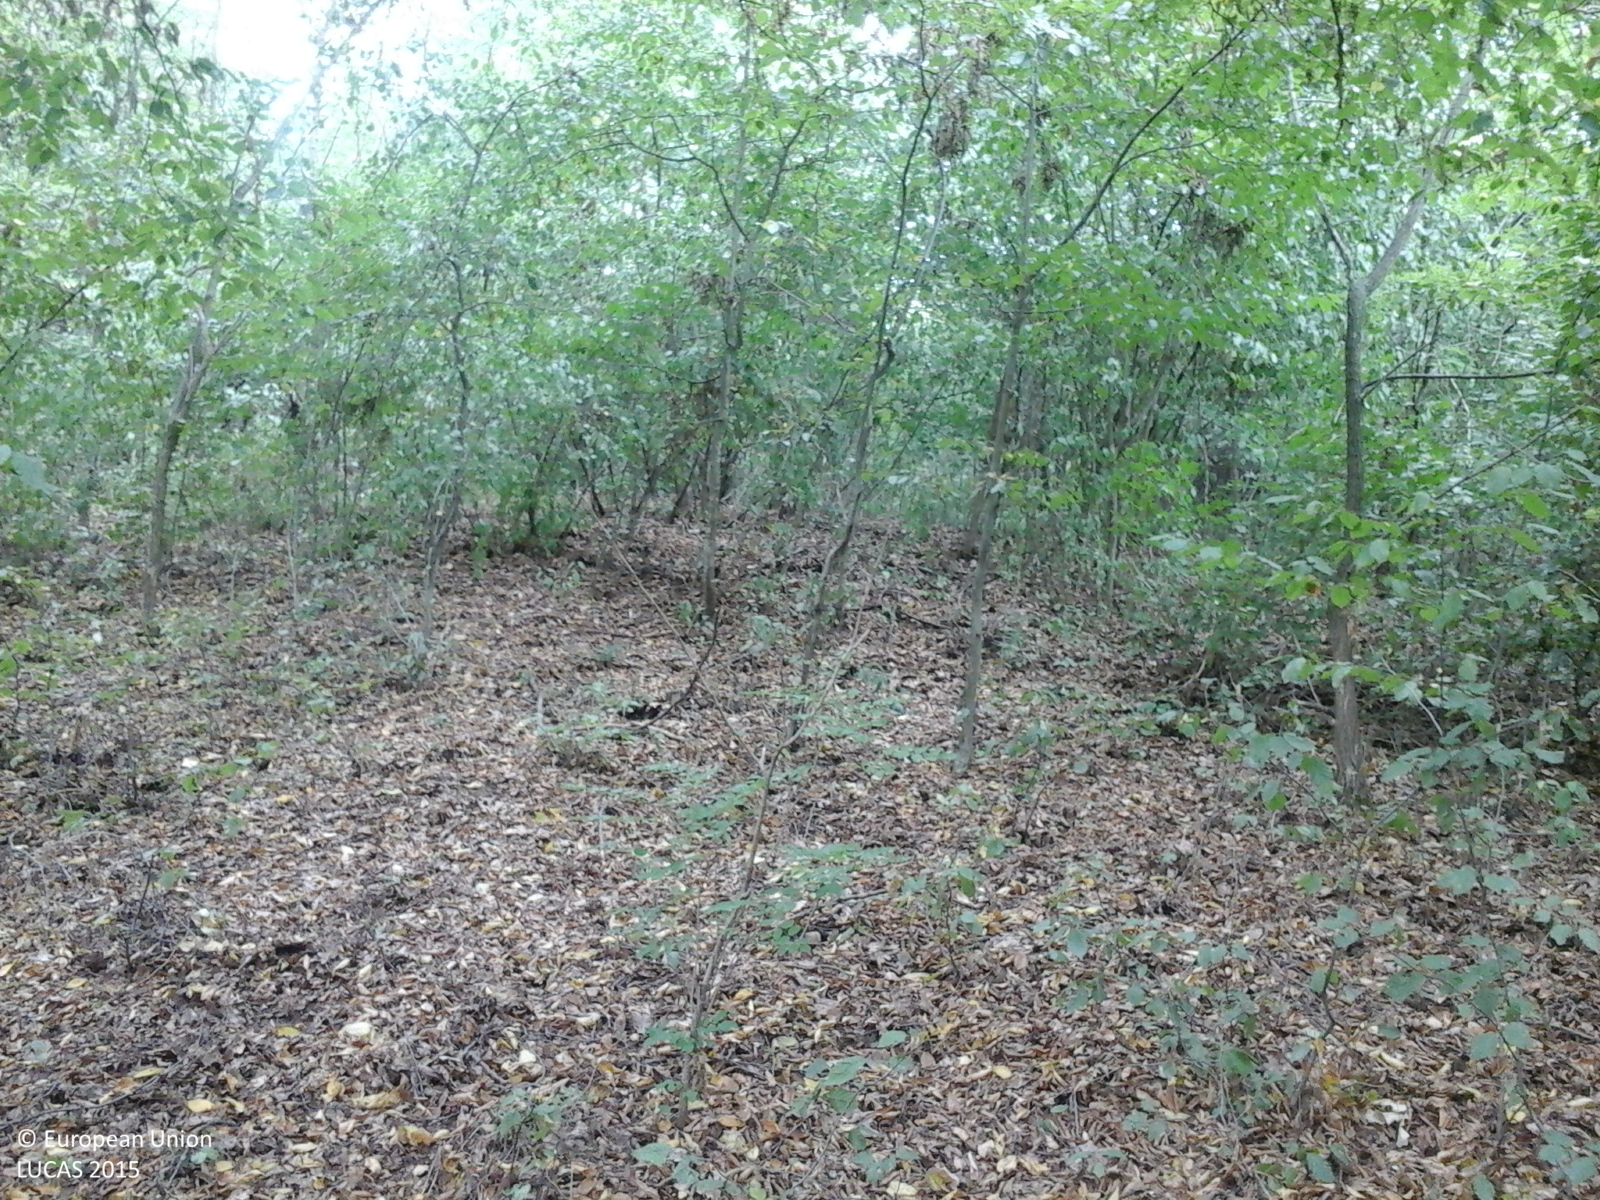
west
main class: Woodland
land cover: Broadleaved woodland
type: mesophytic deciduous forest
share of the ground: > 75 %
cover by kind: broadleaved forest trees 90 %, shrubs 5 %, herbaceous plants 5 %
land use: Forestry
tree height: > 5 m
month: September
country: RO
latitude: 47.5222
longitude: 22.8521
